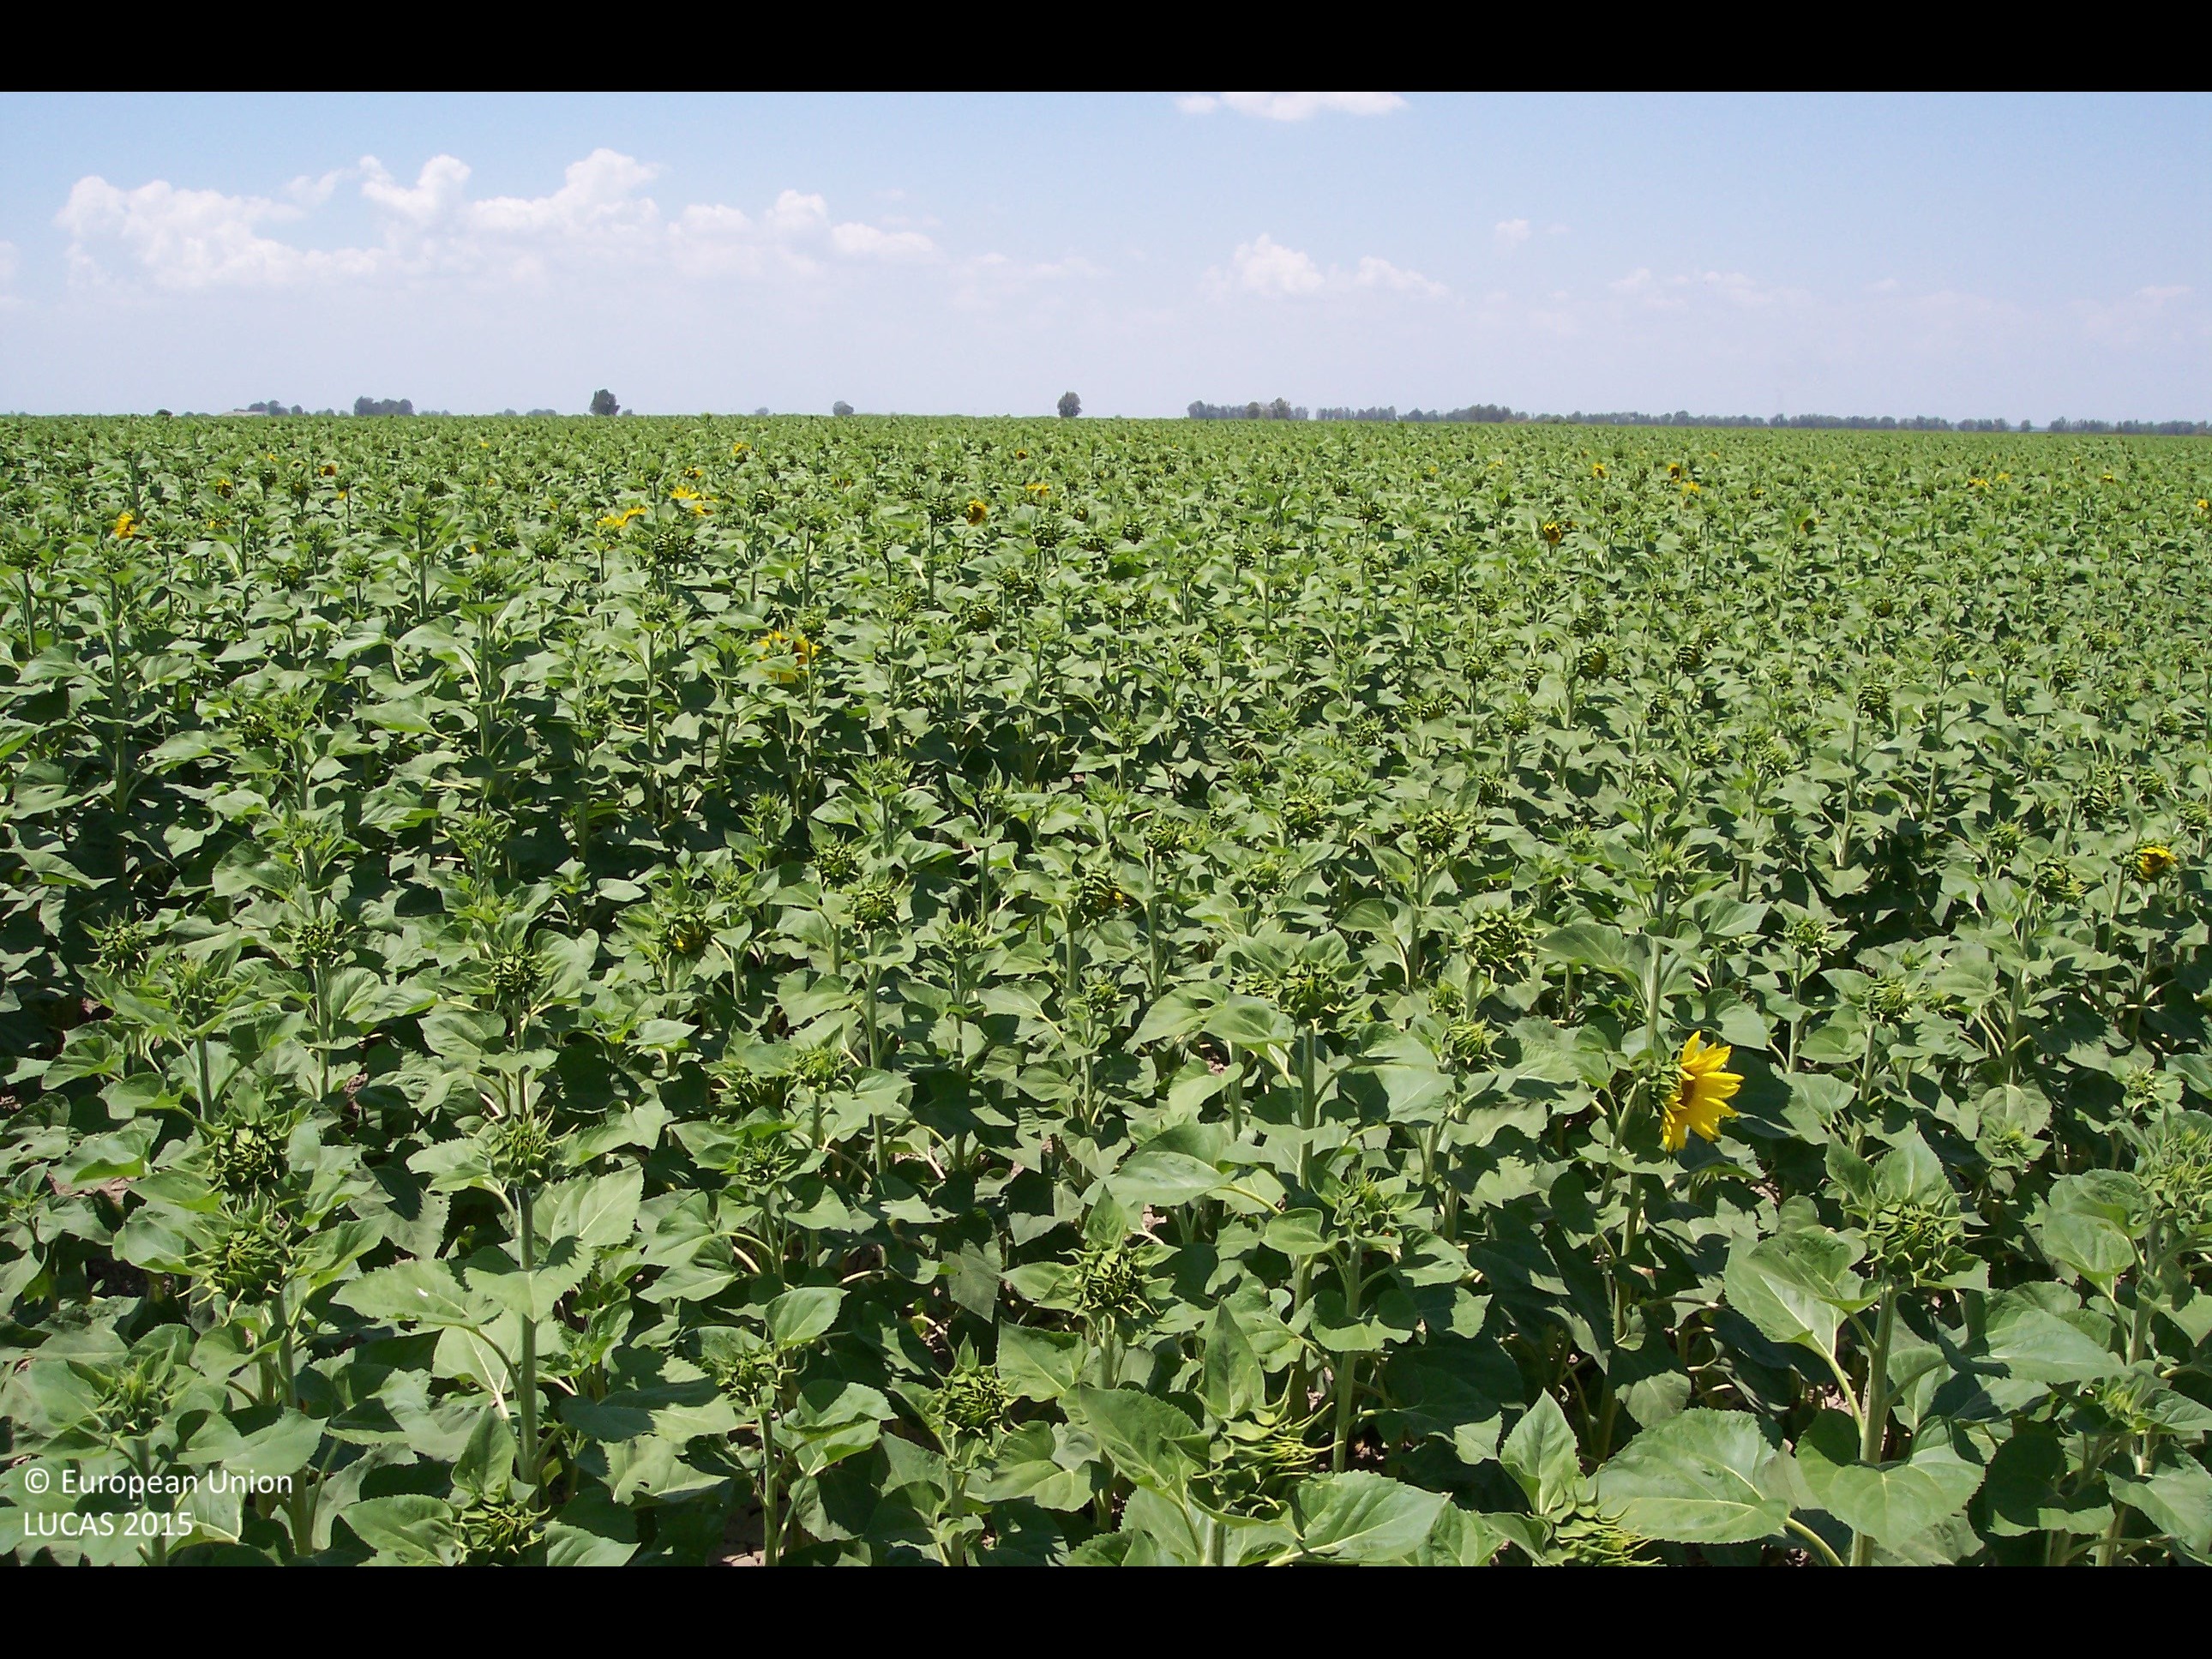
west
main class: Cropland
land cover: Sunflower
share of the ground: > 75 %
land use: Agriculture (excluding fallow land and kitchen gardens)
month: May
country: ES
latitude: 37.1861
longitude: -6.0502
